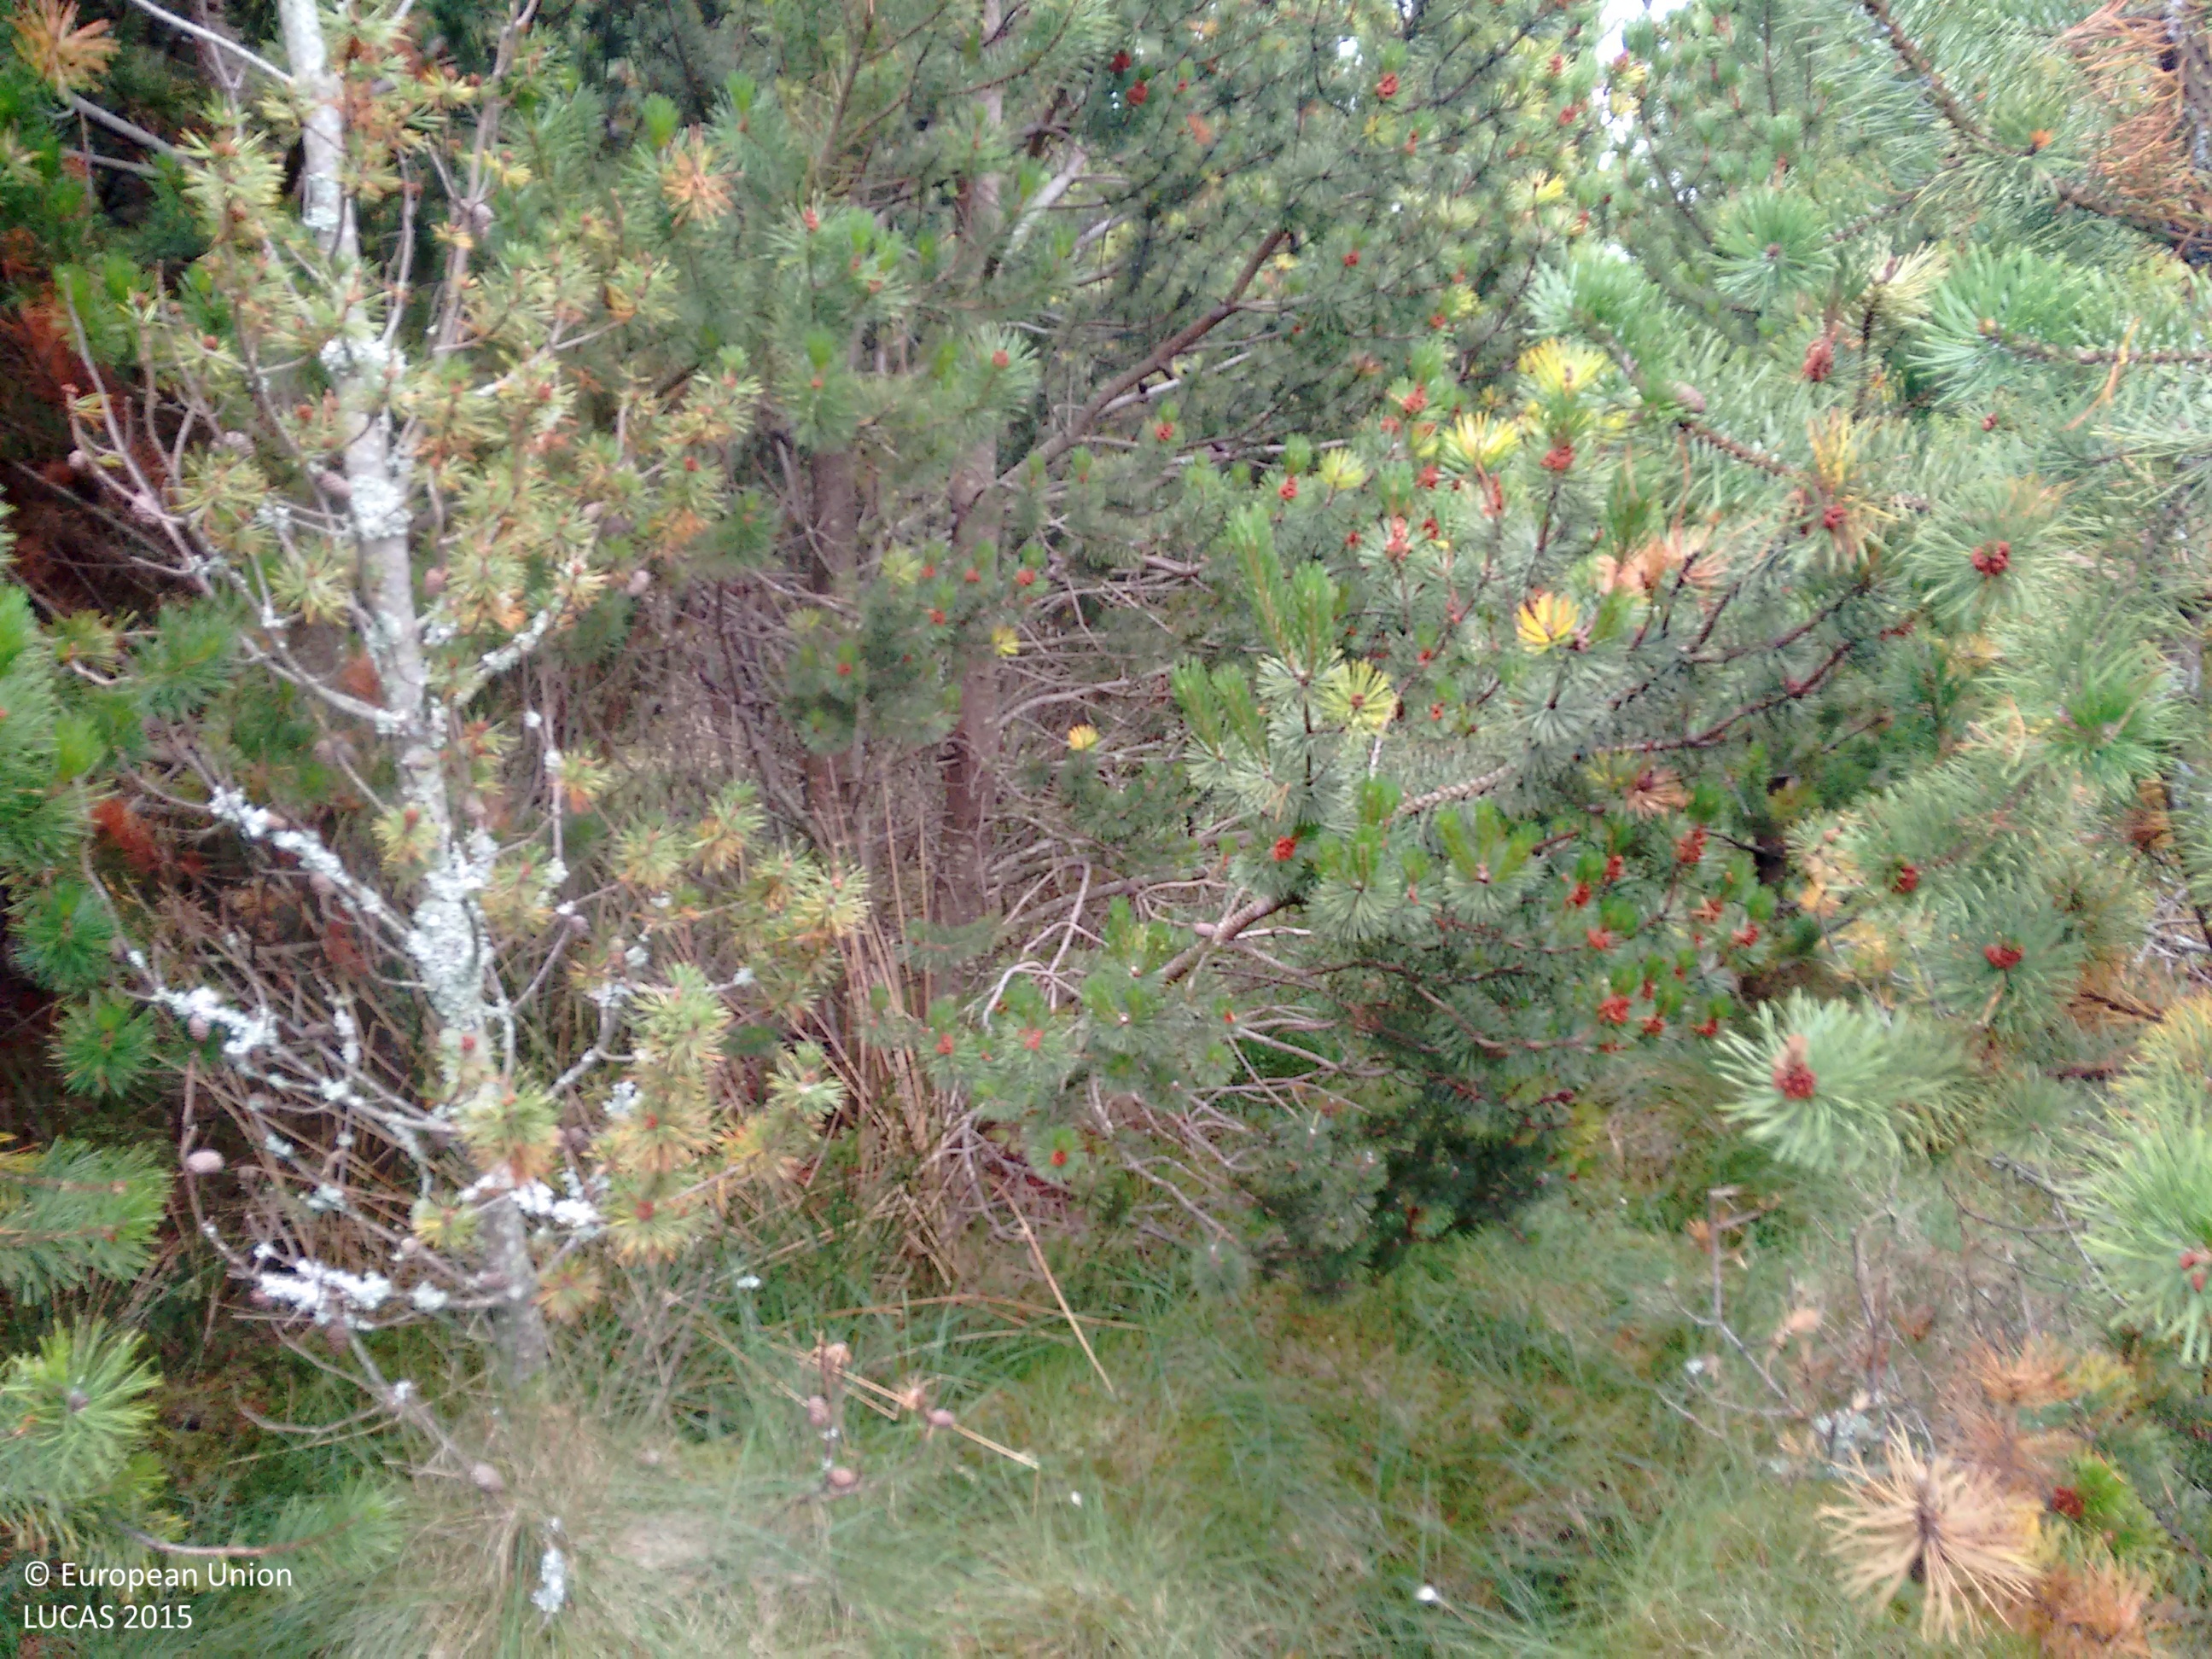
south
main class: Woodland
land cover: Pine dominated coniferous woodland
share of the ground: > 75 %
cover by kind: coniferous forest trees 90 %, herbaceous plants 10 %
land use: Forestry
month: August
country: GB
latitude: 58.3193
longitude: -3.3271
